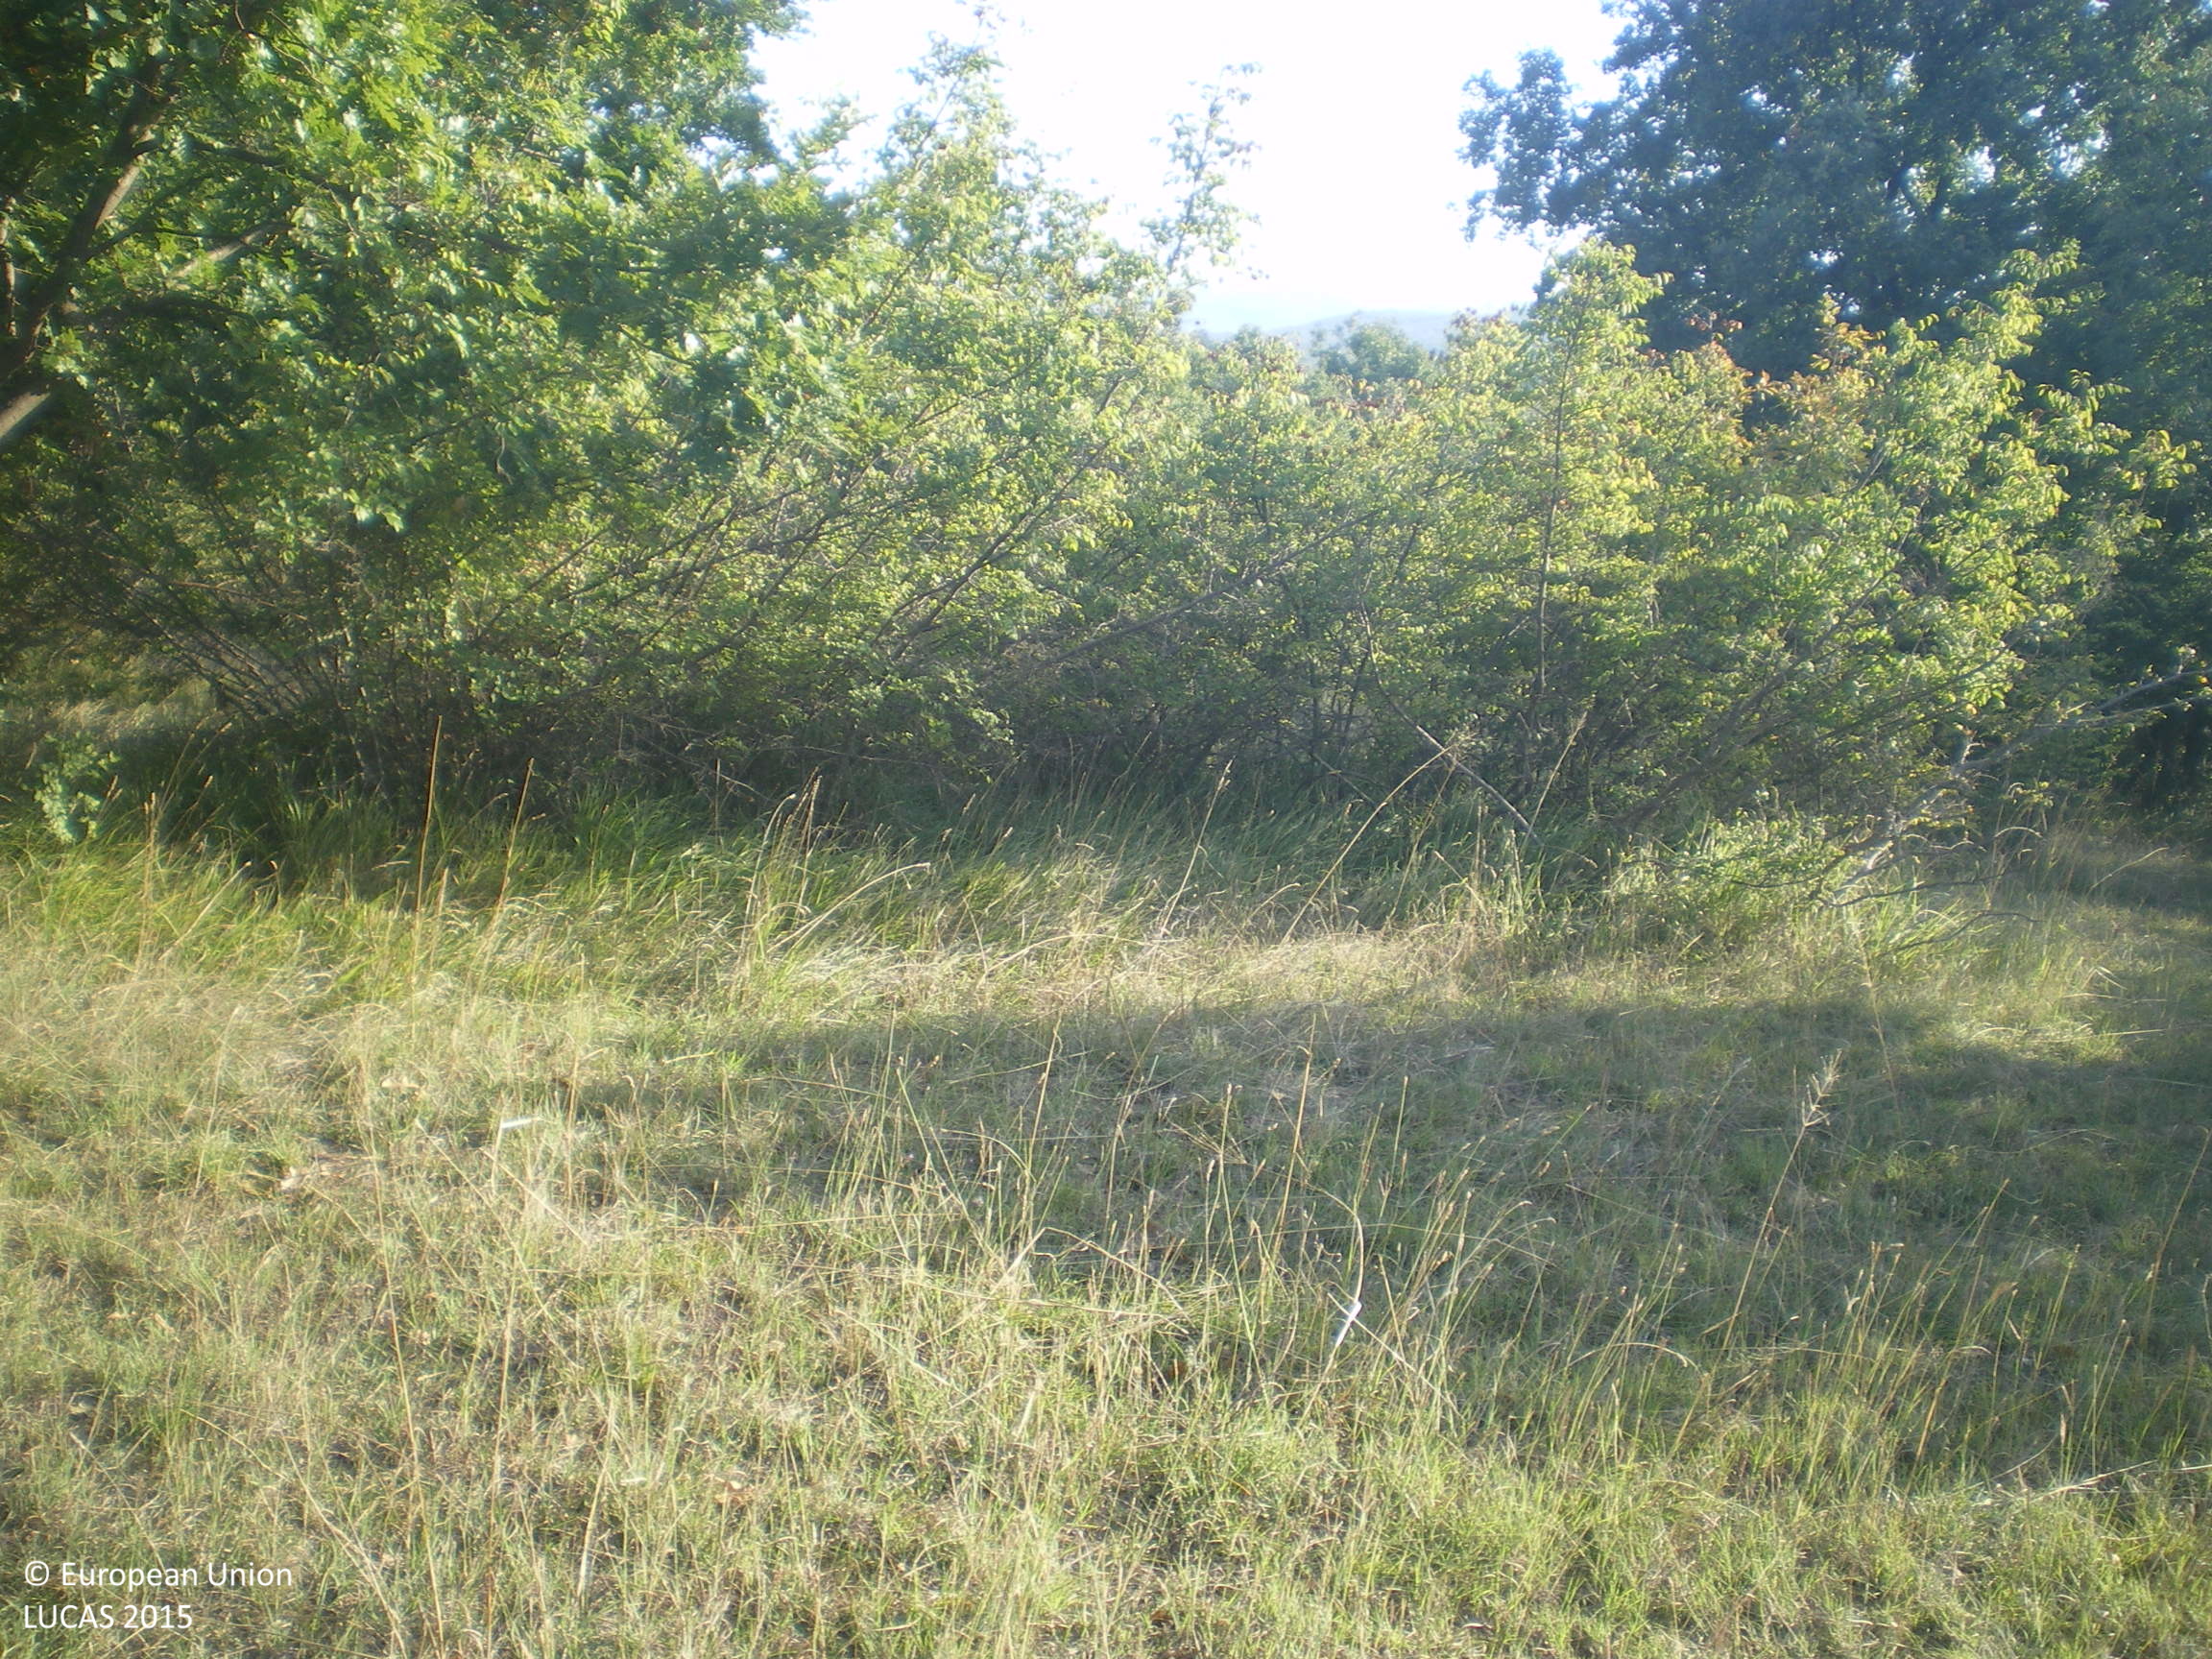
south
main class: Grassland
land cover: Grassland with sparse tree/shrub cover
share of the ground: > 75 %
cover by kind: herbaceous plants 85 %, shrubs 10 %, broadleaved forest trees 5 %
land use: Agriculture (excluding fallow land and kitchen gardens)
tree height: > 5 m
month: September
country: BG
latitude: 41.8051
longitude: 25.8234
